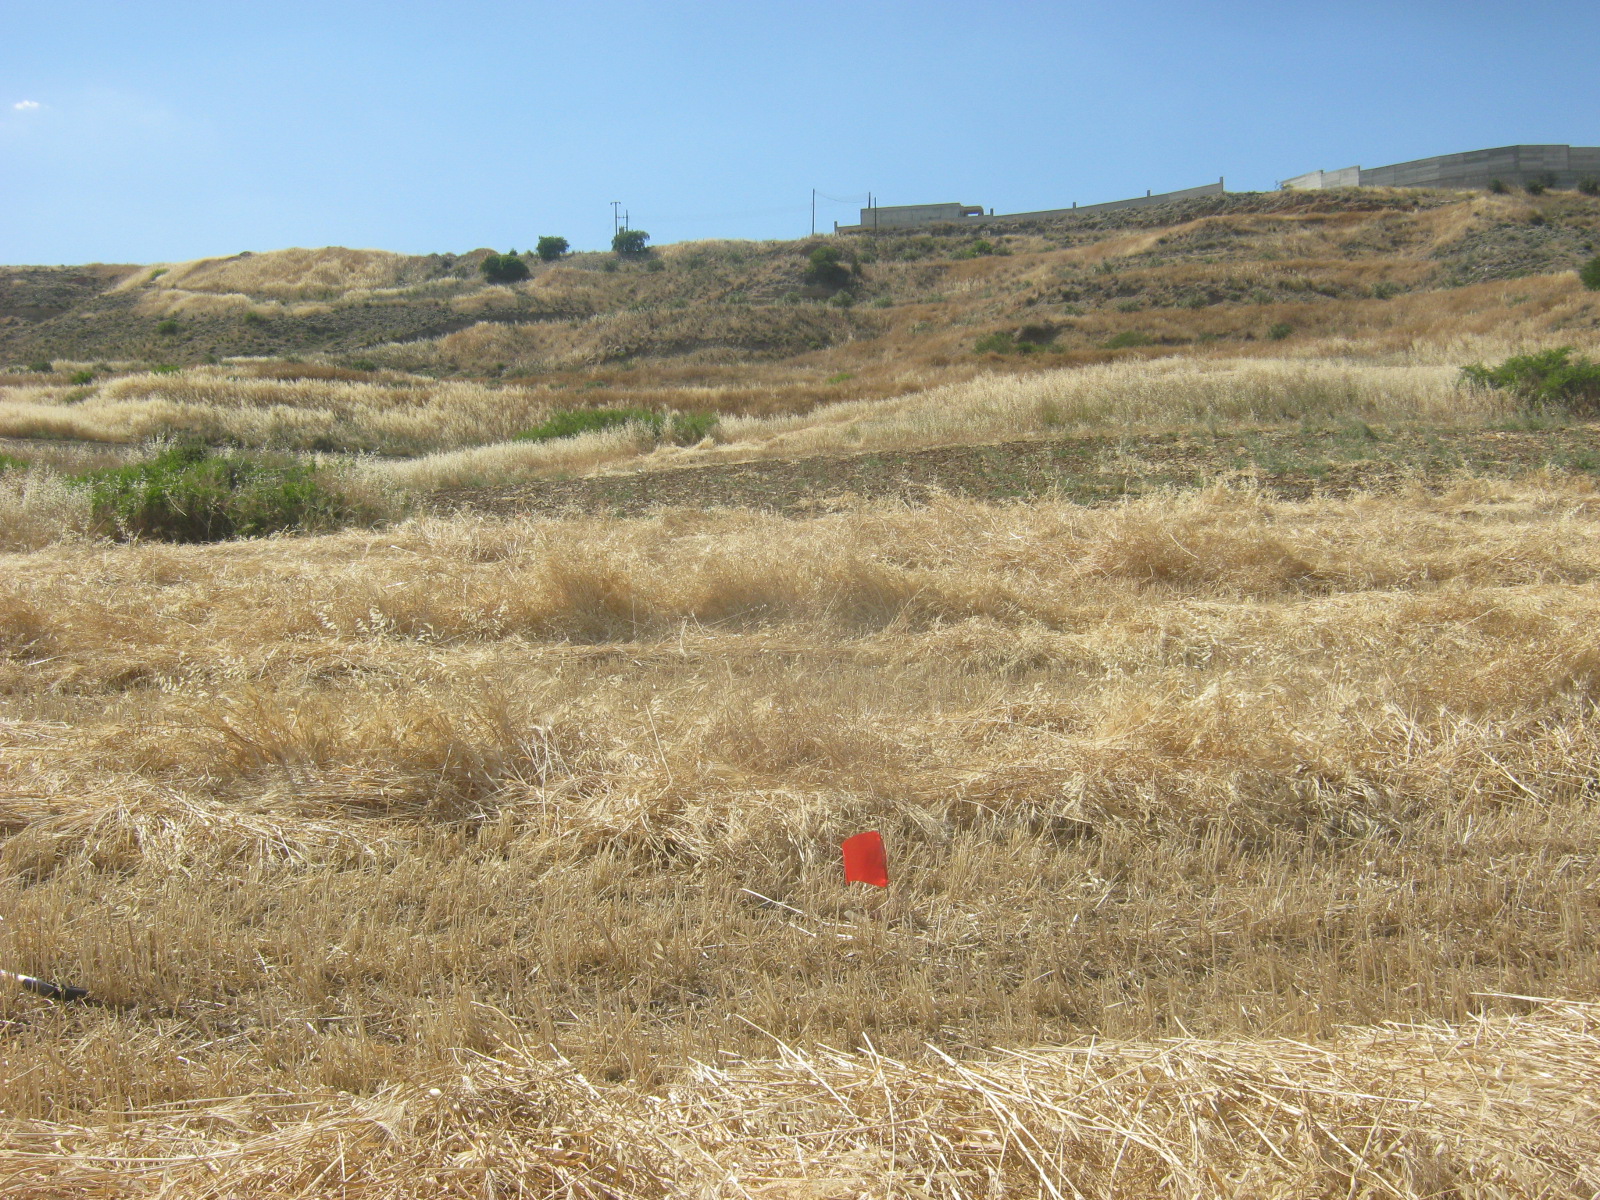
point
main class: Cropland
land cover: Barley
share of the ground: < 10 %
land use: Agriculture (excluding fallow land and kitchen gardens)
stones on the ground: < 10 %
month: May
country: CY
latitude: 35.0790
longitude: 33.2050
